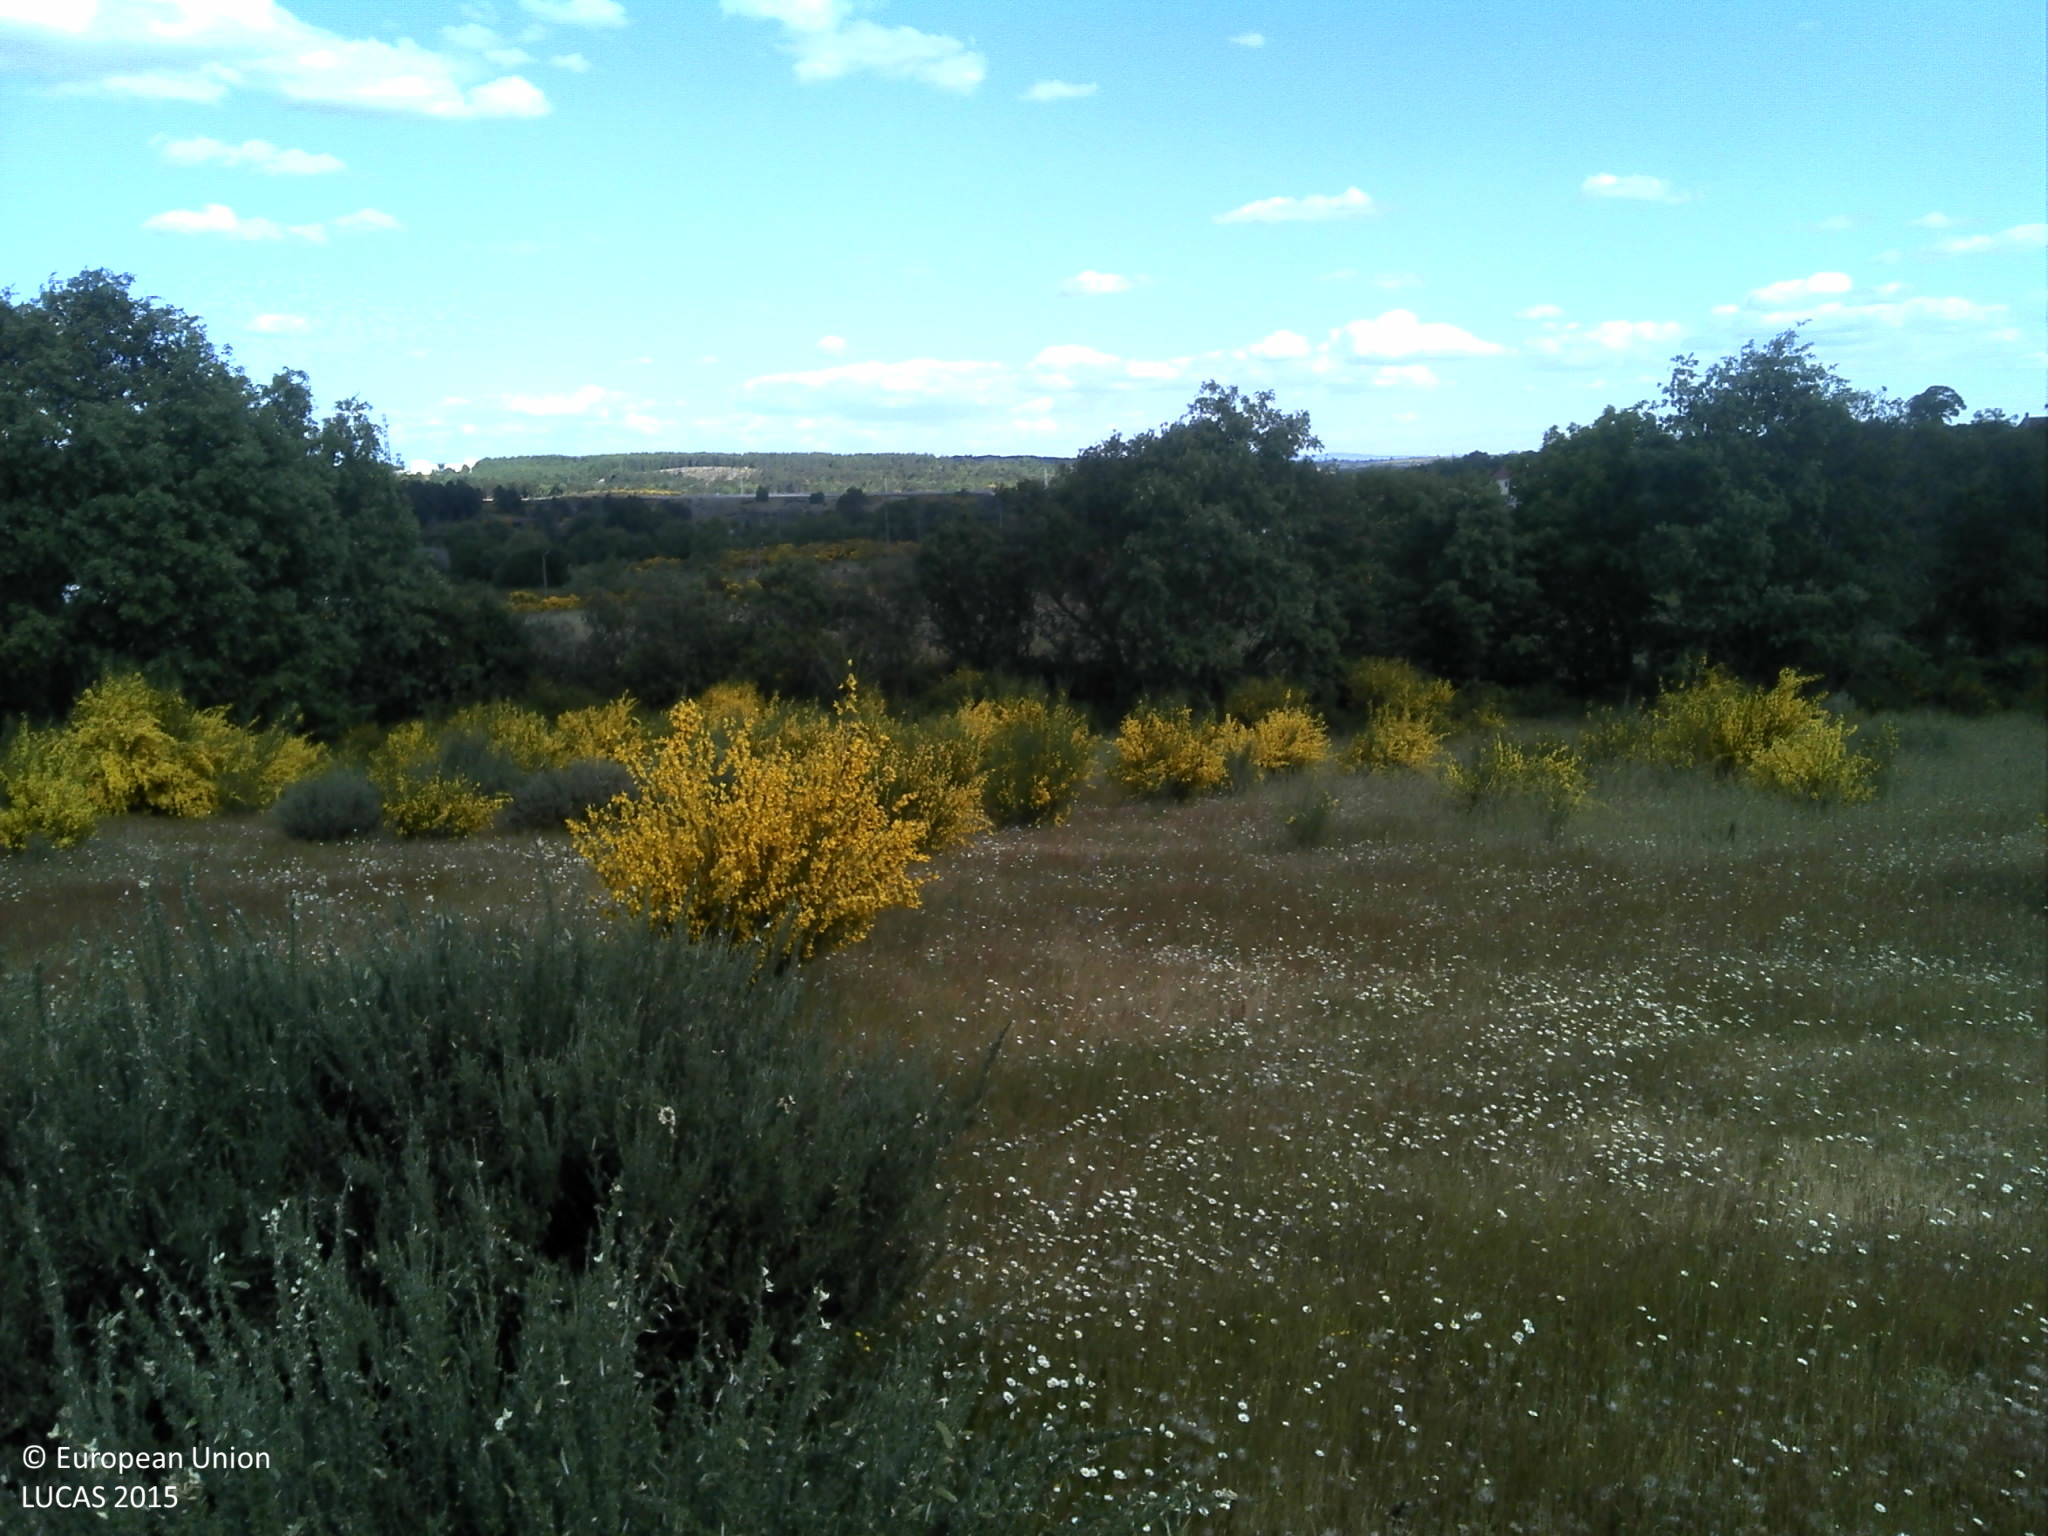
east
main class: Grassland
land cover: Grassland with sparse tree/shrub cover
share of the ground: 50 - 75 %
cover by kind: herbaceous plants 70 %, unconsolidated bare surface 20 %, broadleaved forest trees 5 %, shrubs 5 %
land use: Agriculture (excluding fallow land and kitchen gardens)
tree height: > 5 m
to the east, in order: Grassland with sparse tree/shrub cover; Abandoned hedges; Rivers and streams; Abandoned hedges; Grassland without tree/shrub cover; Fences; Grass margins; Railways
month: May
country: PT
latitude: 40.5366
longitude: -7.2358
